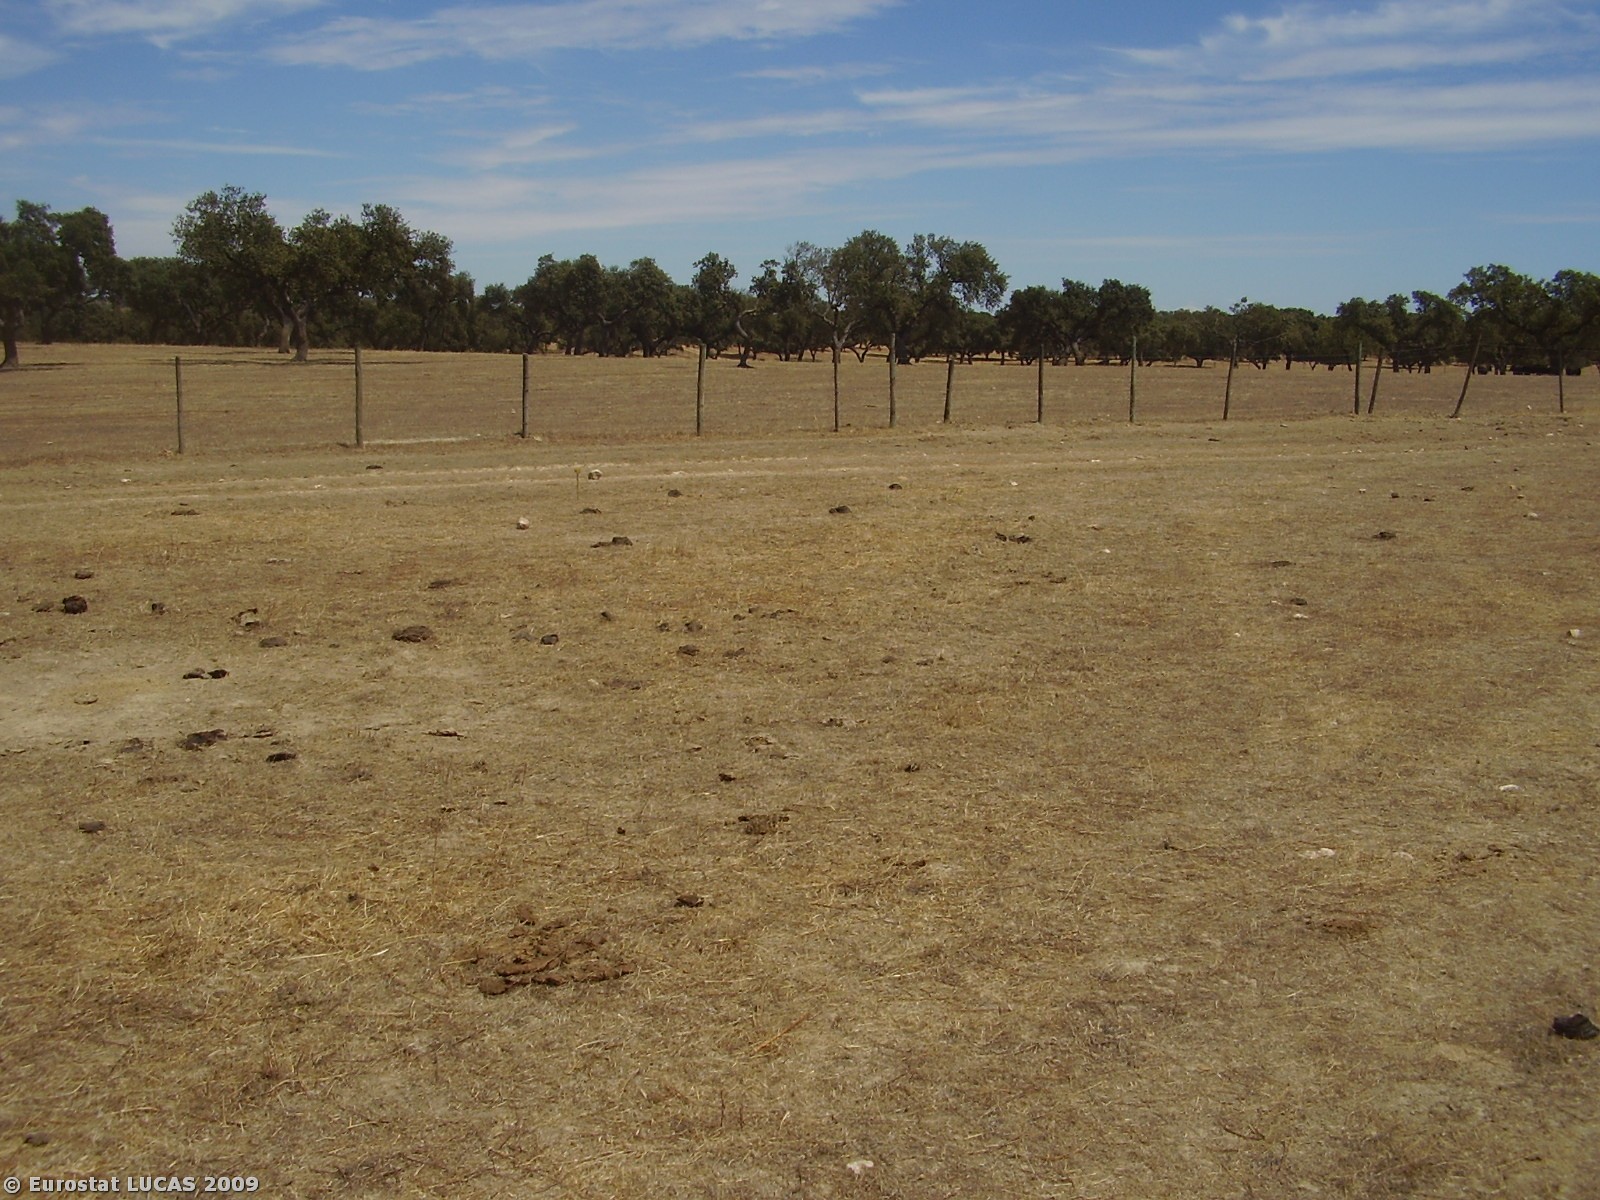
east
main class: Woodland
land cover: Broadleaved woodland
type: broadleaved evergreen forest
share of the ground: 10 - 25 %
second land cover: Grassland with sparse tree/shrub cover
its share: > 75 %
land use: Forestry
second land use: Fallow land
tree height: > 5 m
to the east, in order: Broadleaved woodland; Grassland with sparse tree/shrub cover; Broadleaved woodland; Fences; Broadleaved woodland
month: August
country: PT
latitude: 38.2607
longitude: -7.1712
